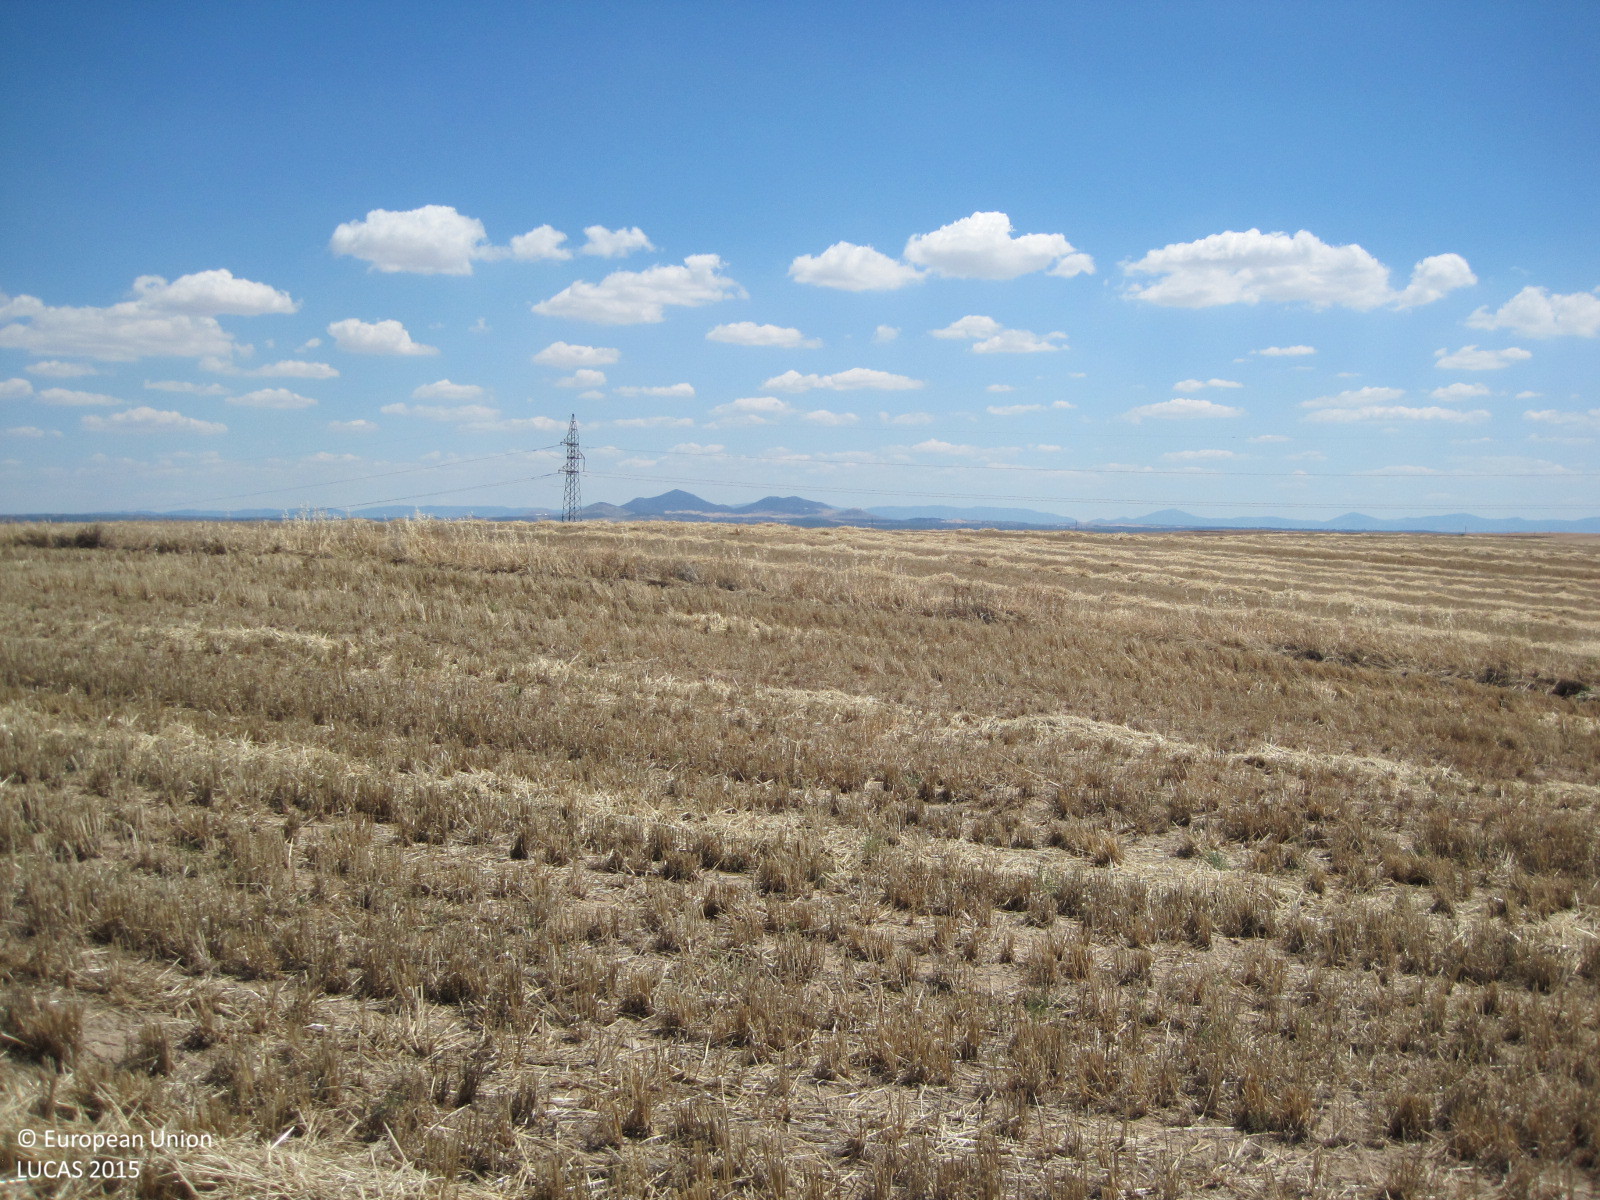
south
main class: Cropland
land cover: Barley
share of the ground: < 10 %
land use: Agriculture (excluding fallow land and kitchen gardens)
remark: Harvested field
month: June
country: ES
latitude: 39.8966
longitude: -4.2720
